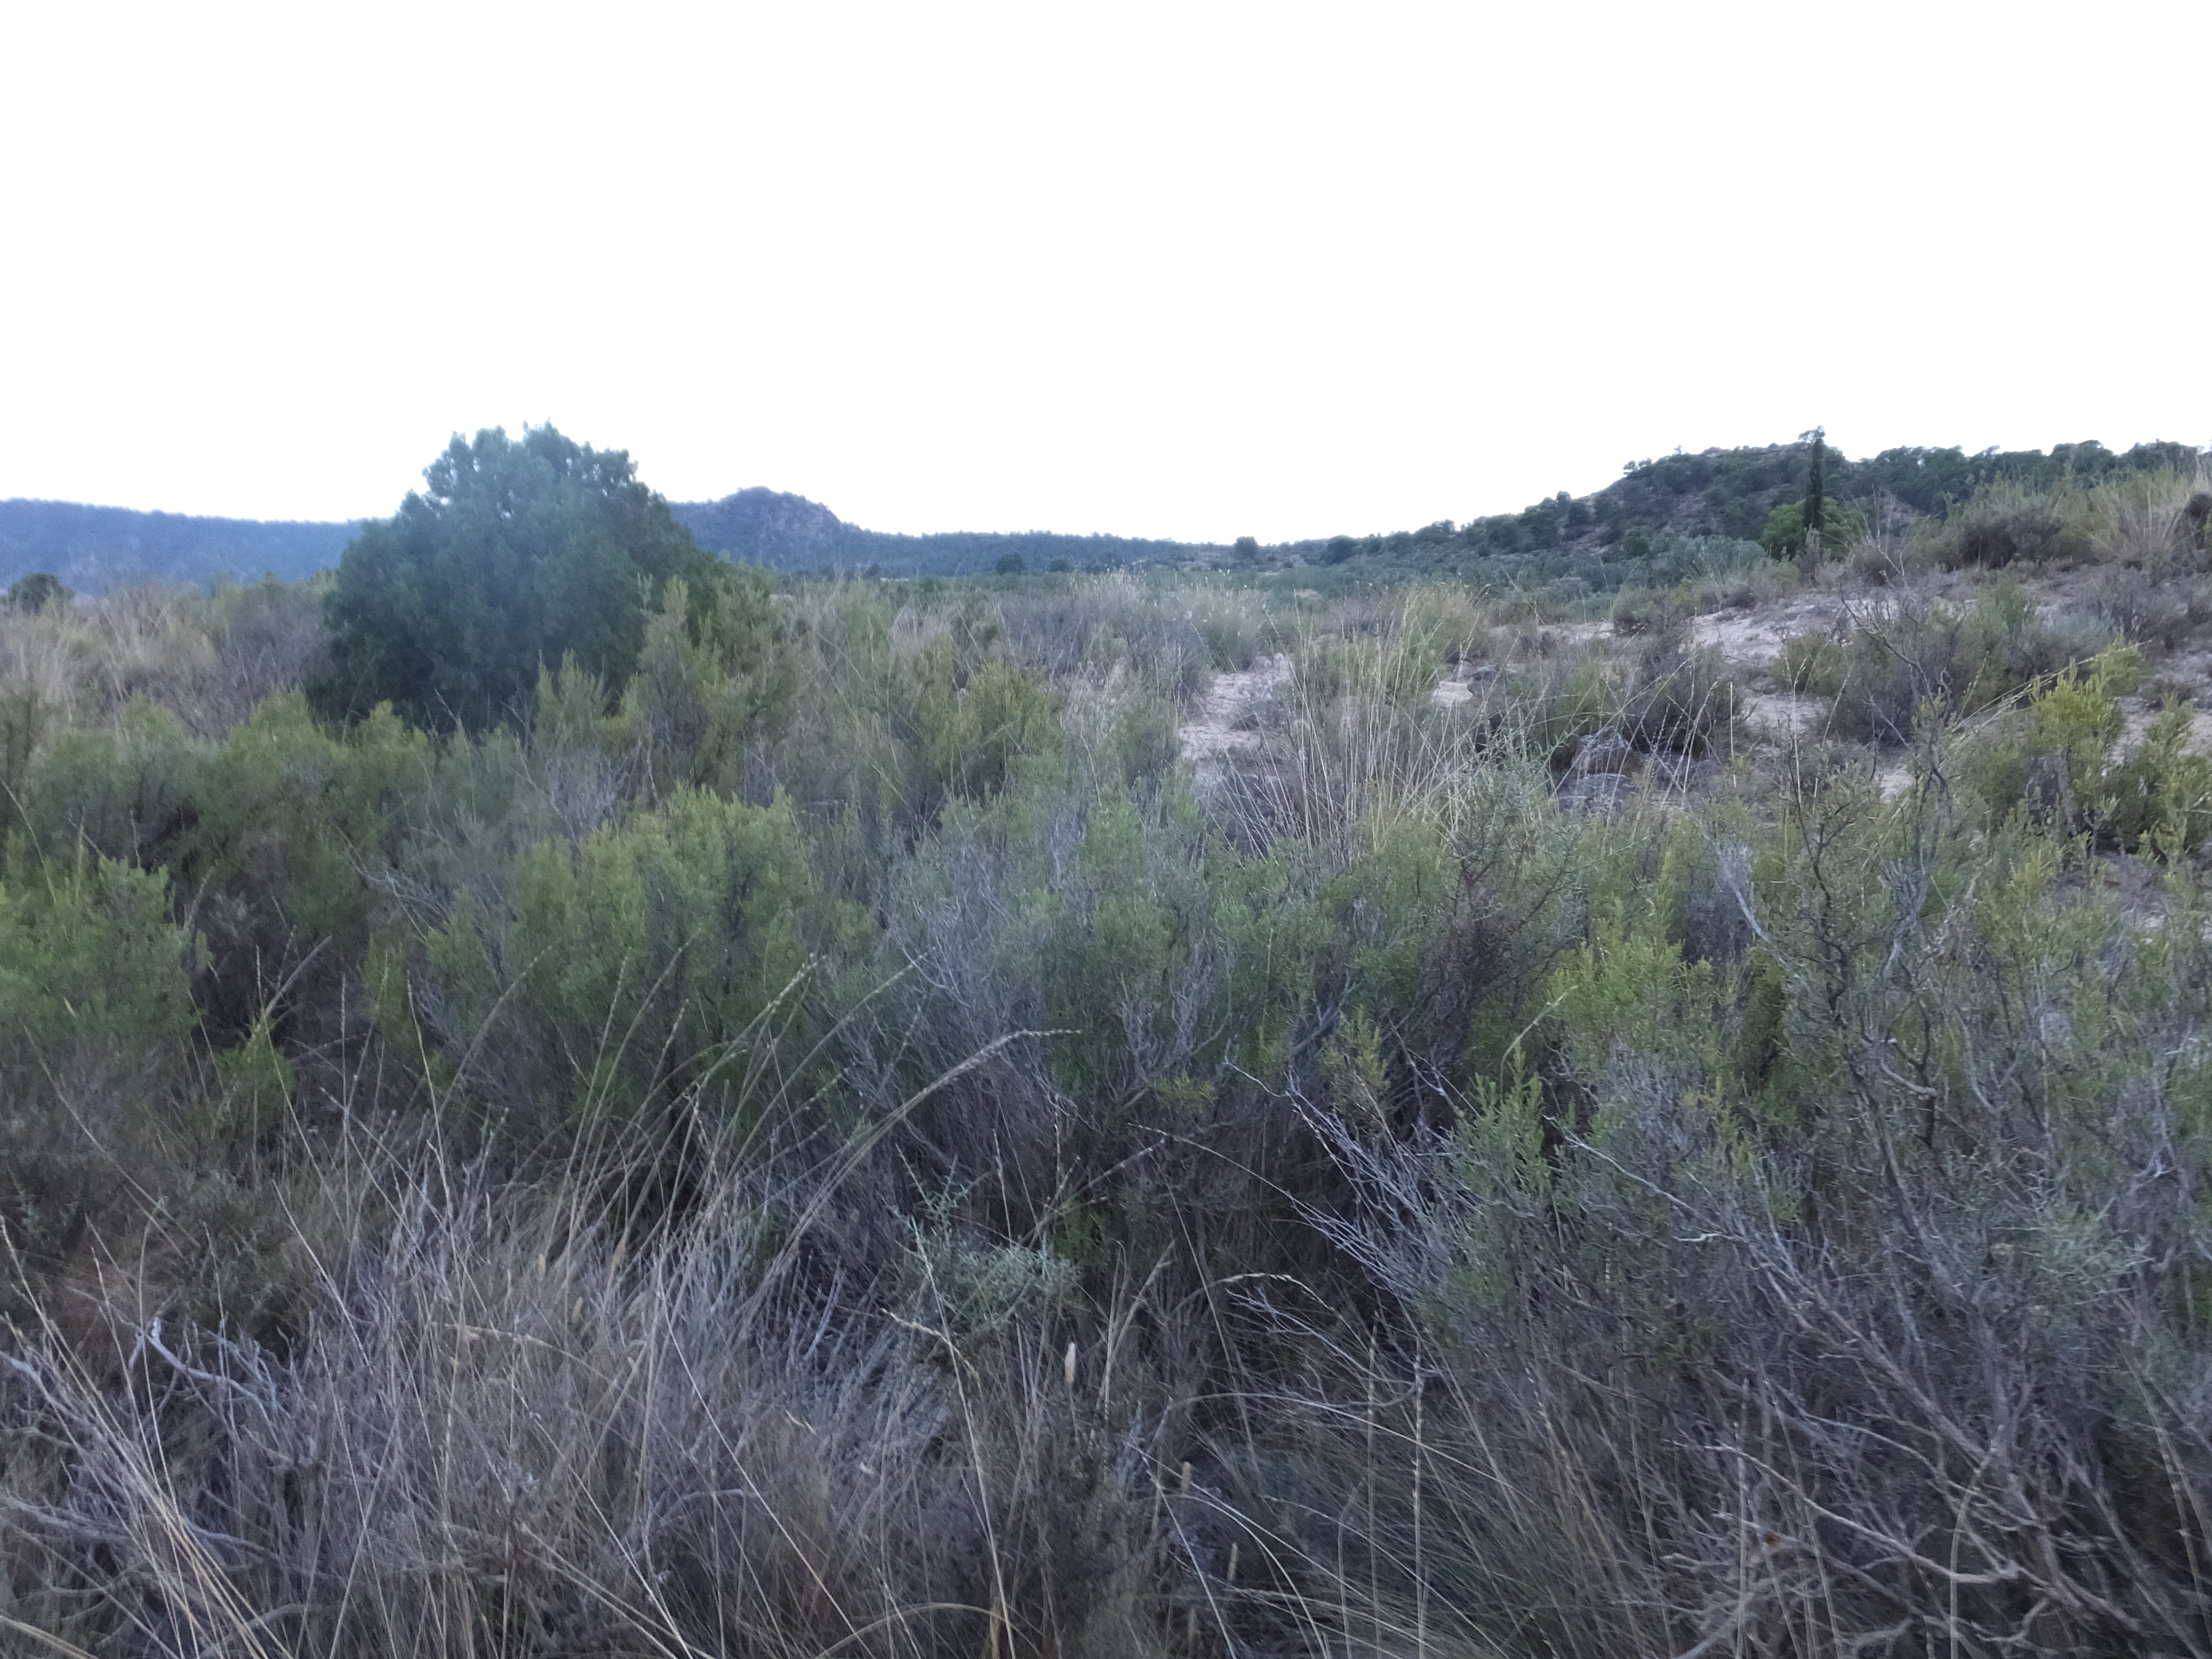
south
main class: Shrubland
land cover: Shrubland without tree cover
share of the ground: > 75 %
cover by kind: shrubs 75 %, herbaceous plants 25 %
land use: Semi-natural and natural areas not in use
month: July
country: ES
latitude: 41.1647
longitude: -0.1070
